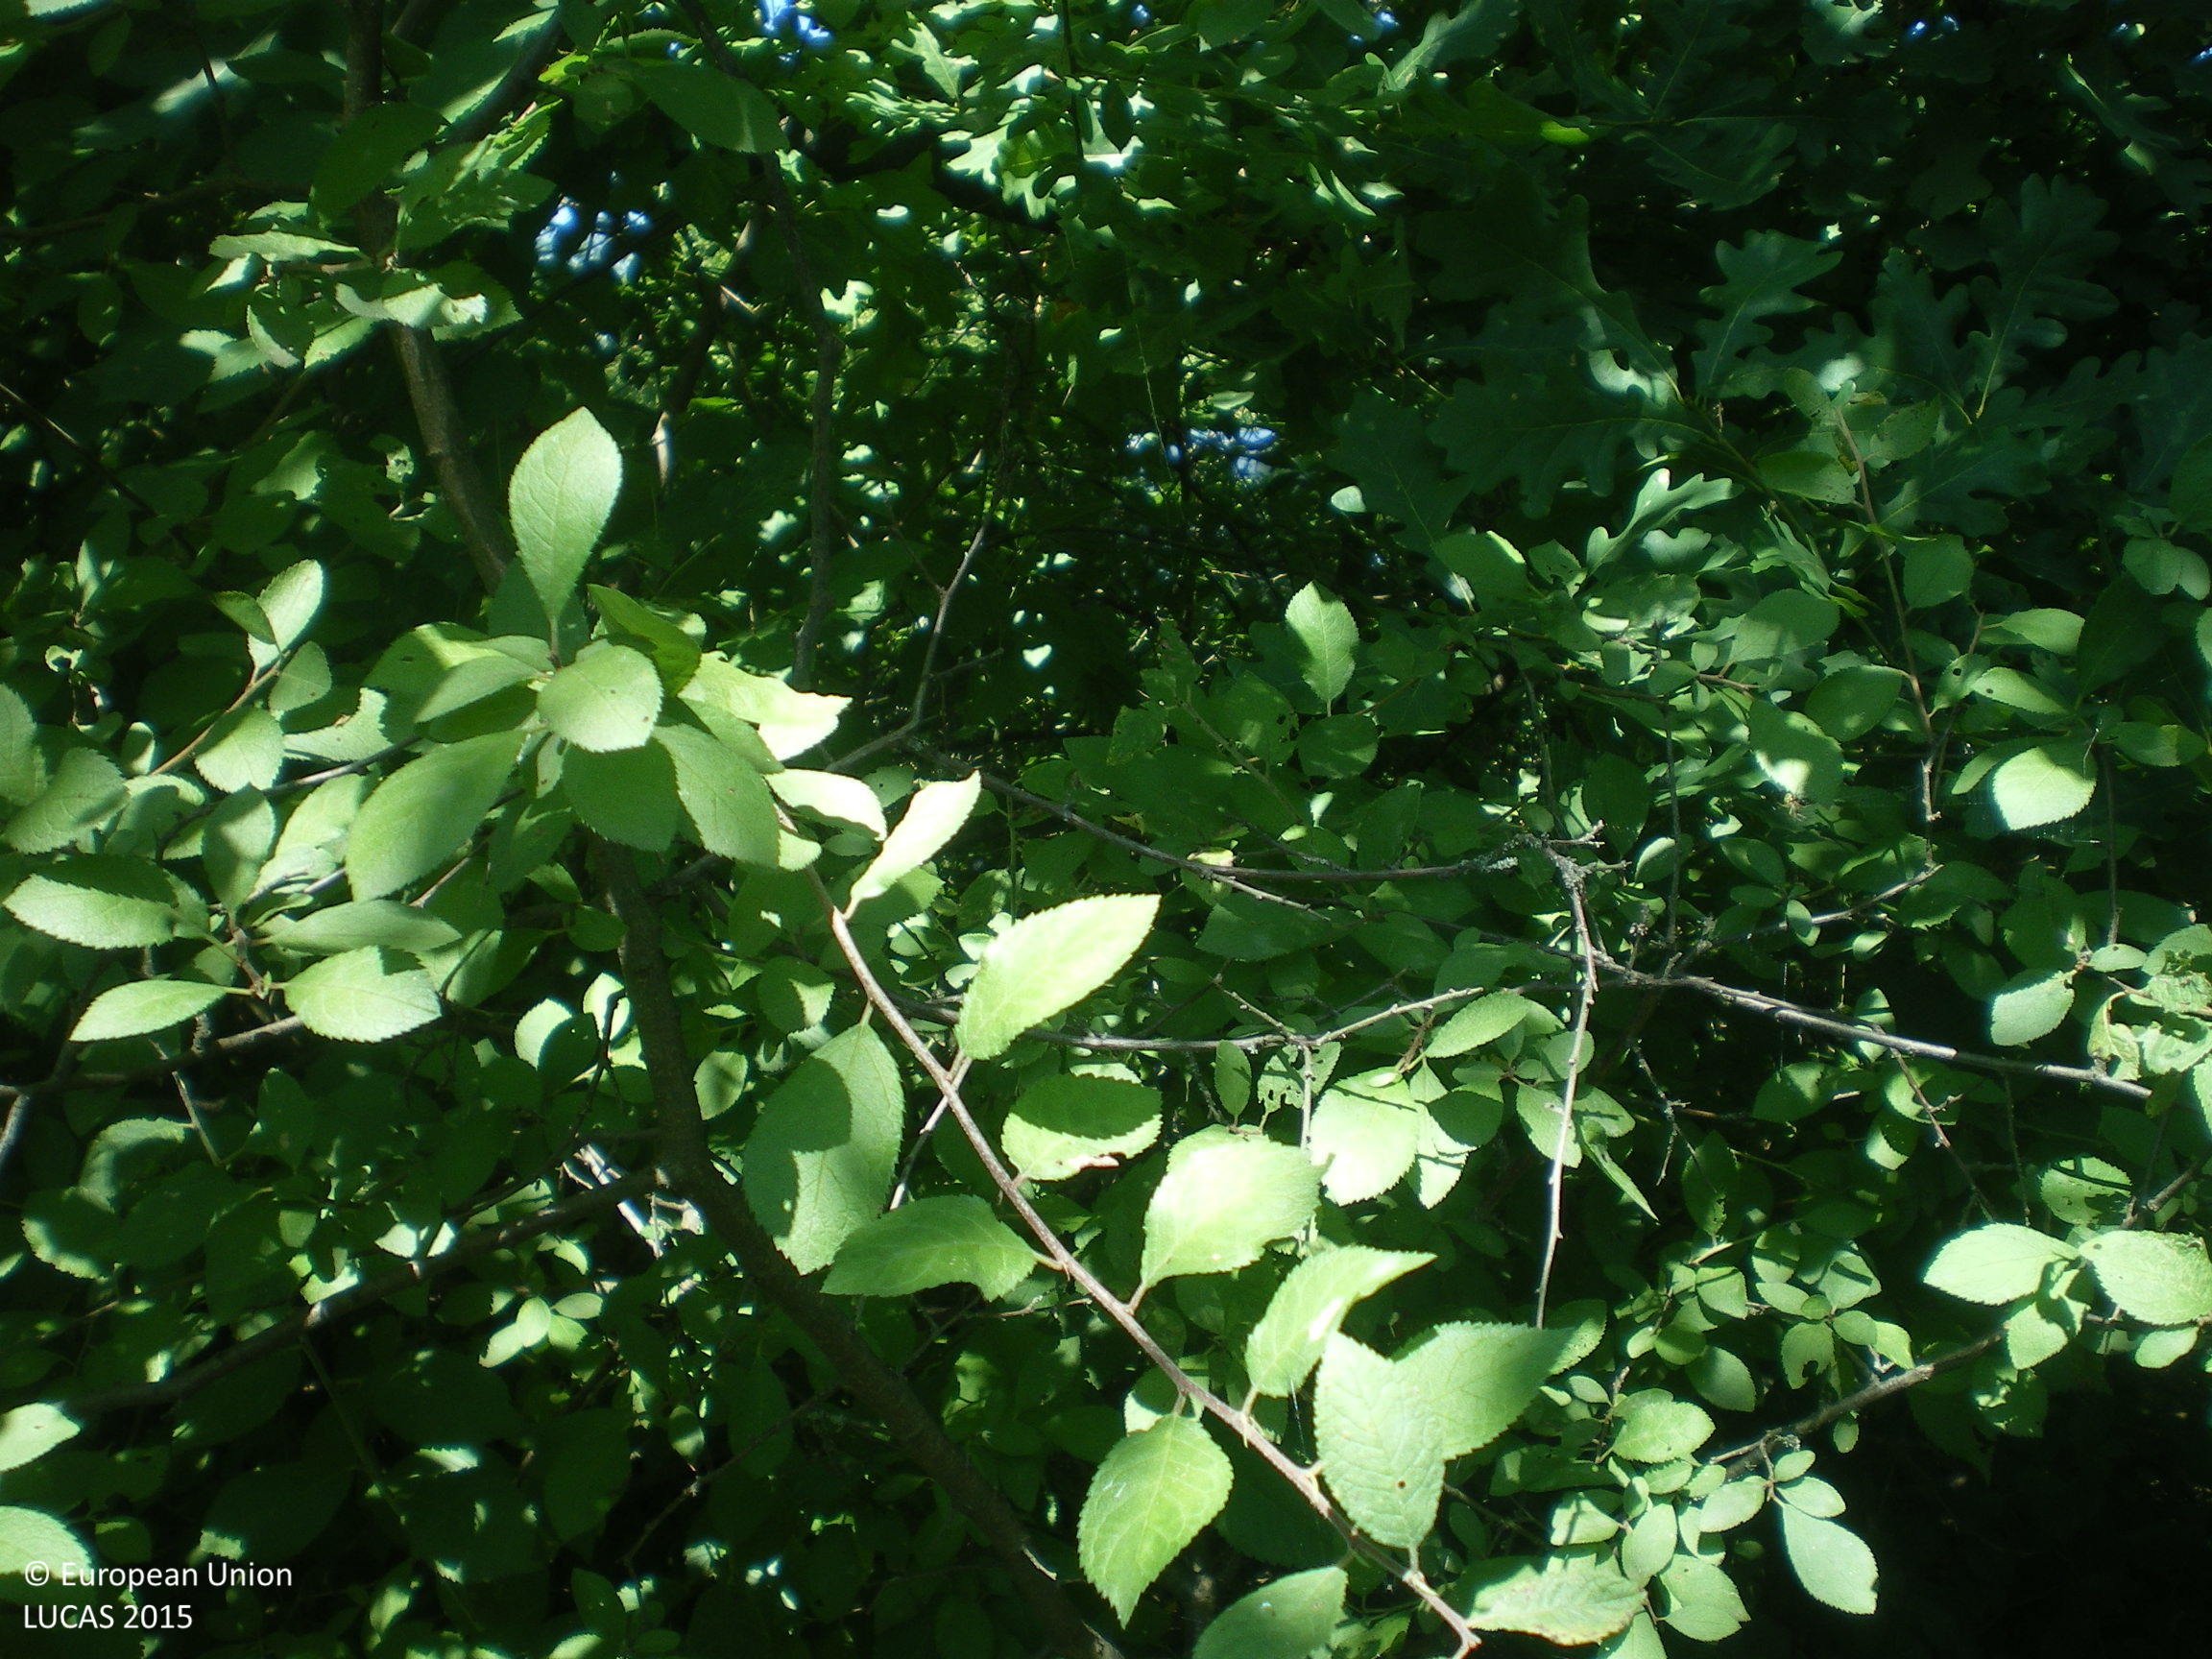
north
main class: Woodland
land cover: Broadleaved woodland
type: mesophytic deciduous forest
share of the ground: > 75 %
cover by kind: broadleaved forest trees 95 %, shrubs 5 %
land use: Forestry
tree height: > 5 m
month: July
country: BG
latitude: 42.4054
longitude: 25.8597
